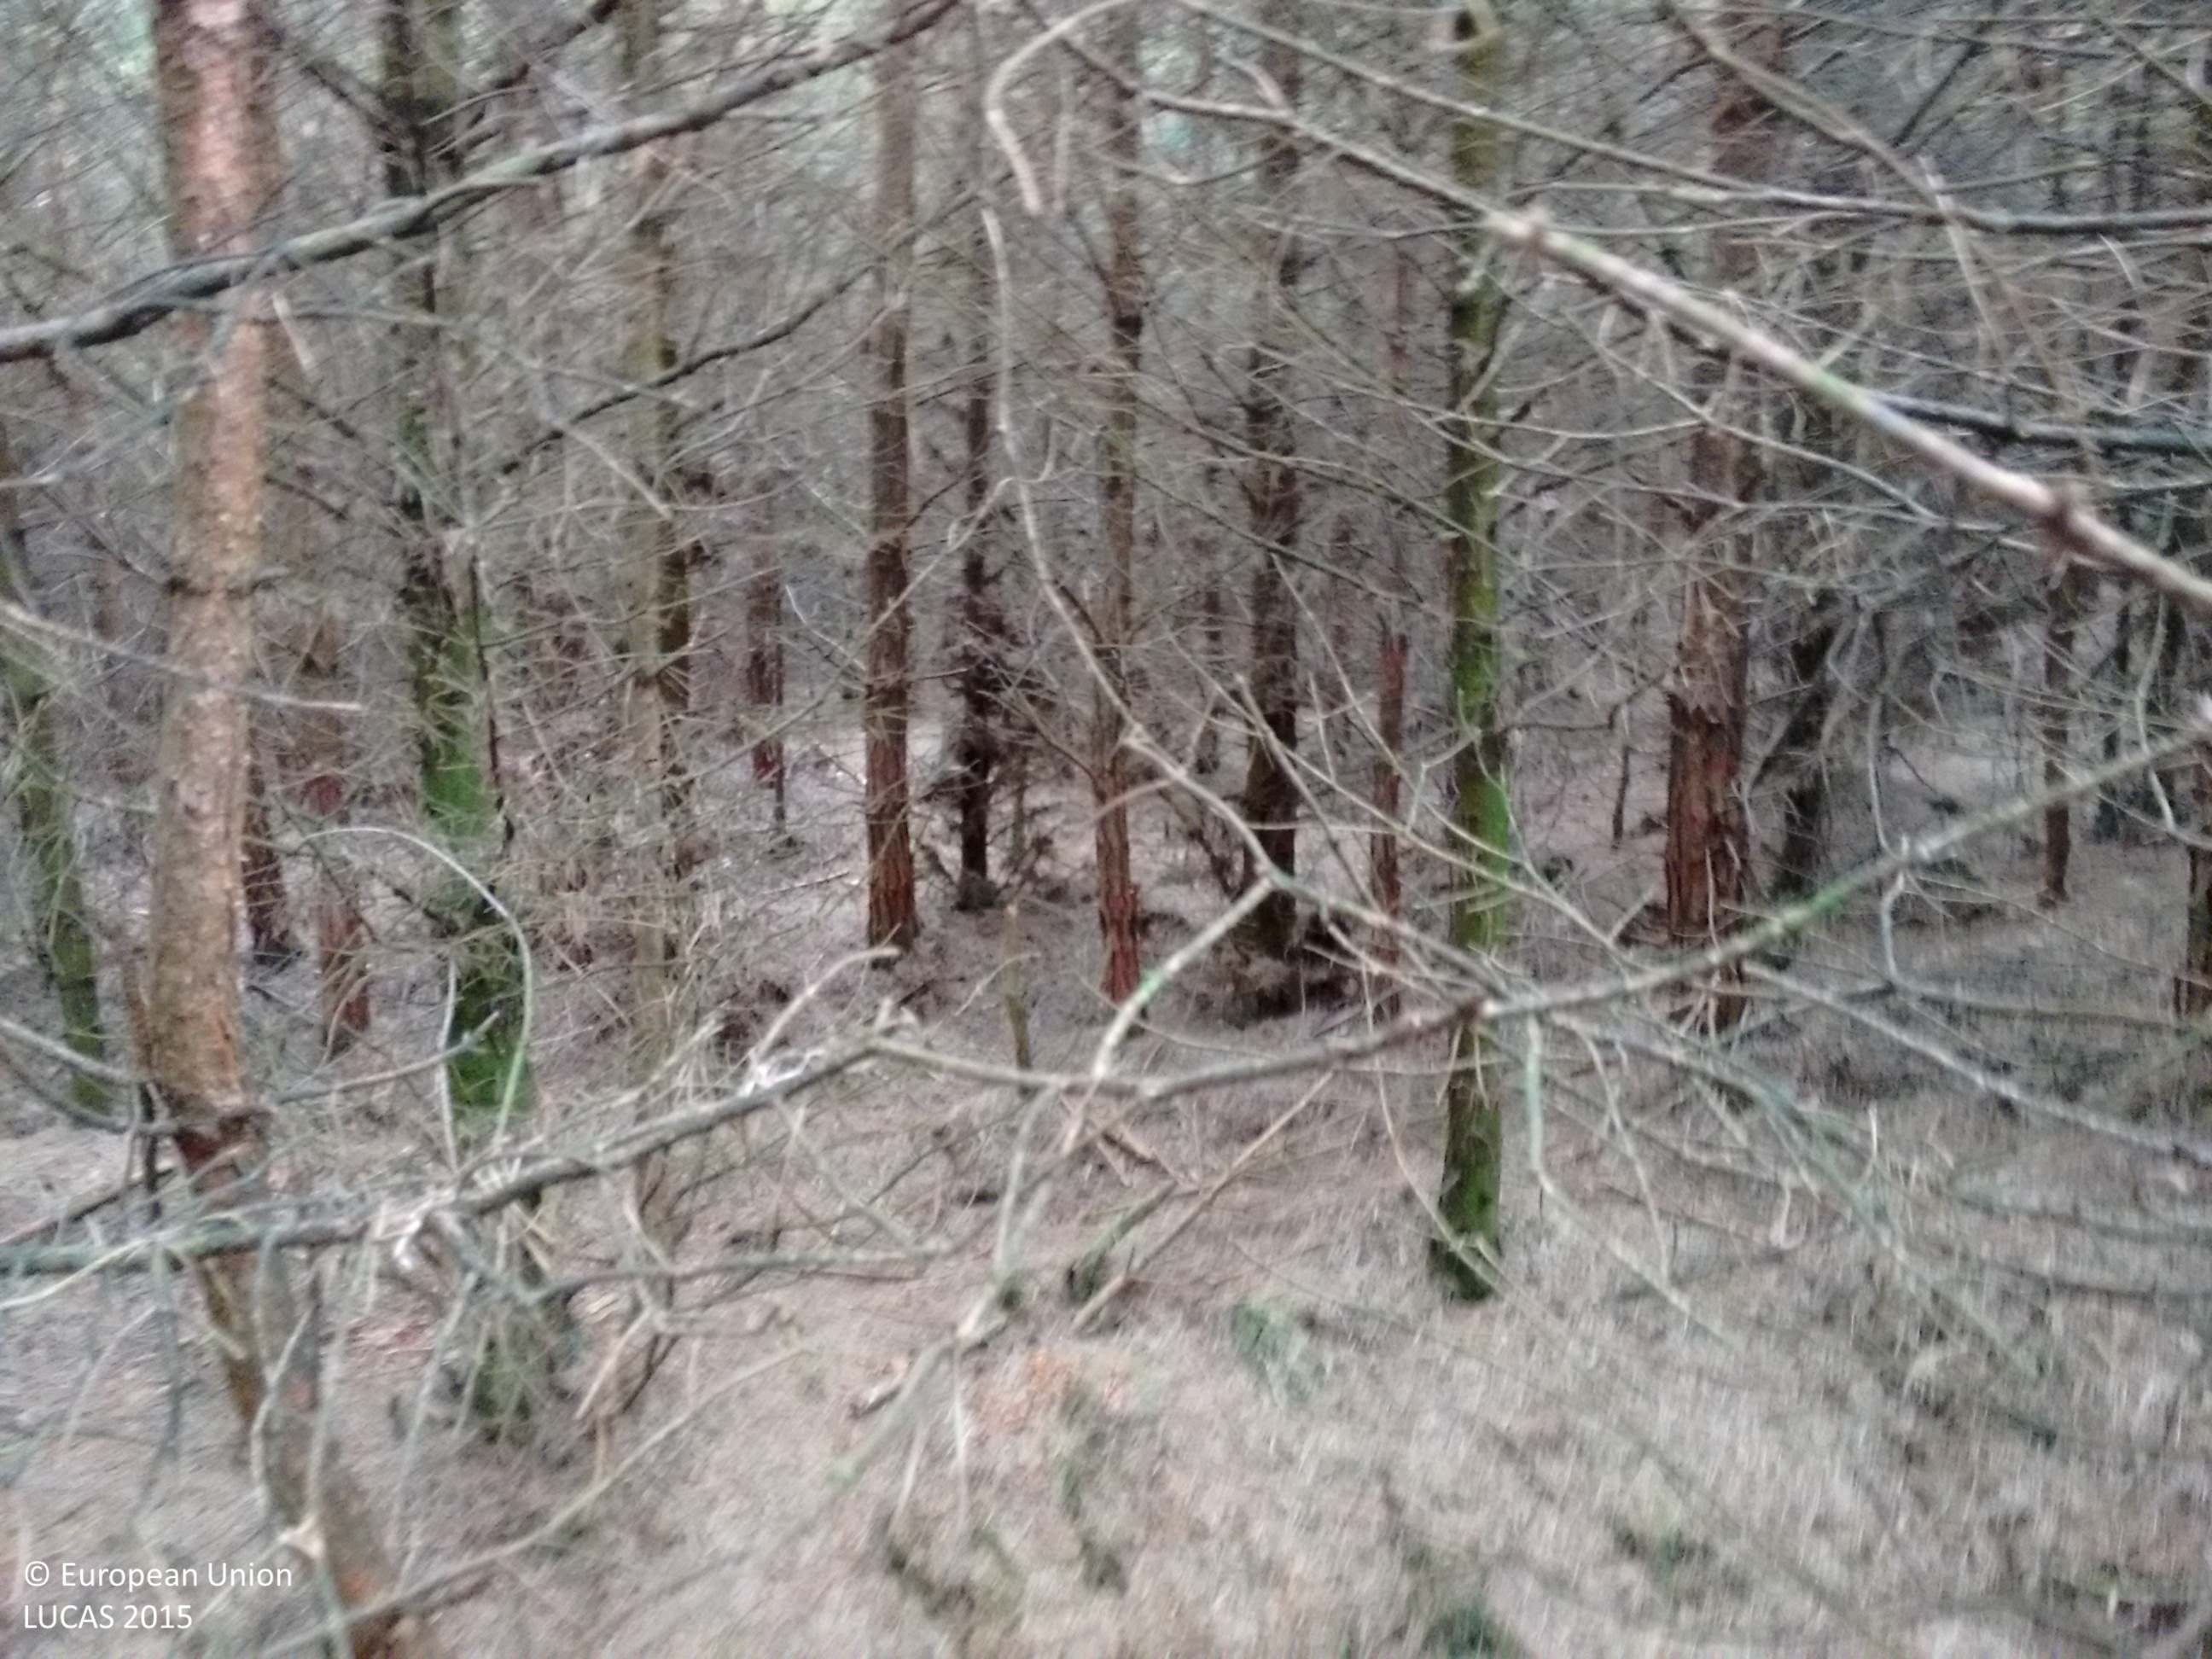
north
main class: Woodland
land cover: Pine dominated coniferous woodland
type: exotic forest
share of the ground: > 75 %
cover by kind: coniferous forest trees 80 %, broadleaved forest trees 20 %
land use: Forestry
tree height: > 5 m
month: June
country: GB
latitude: 54.3107
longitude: -0.8455
